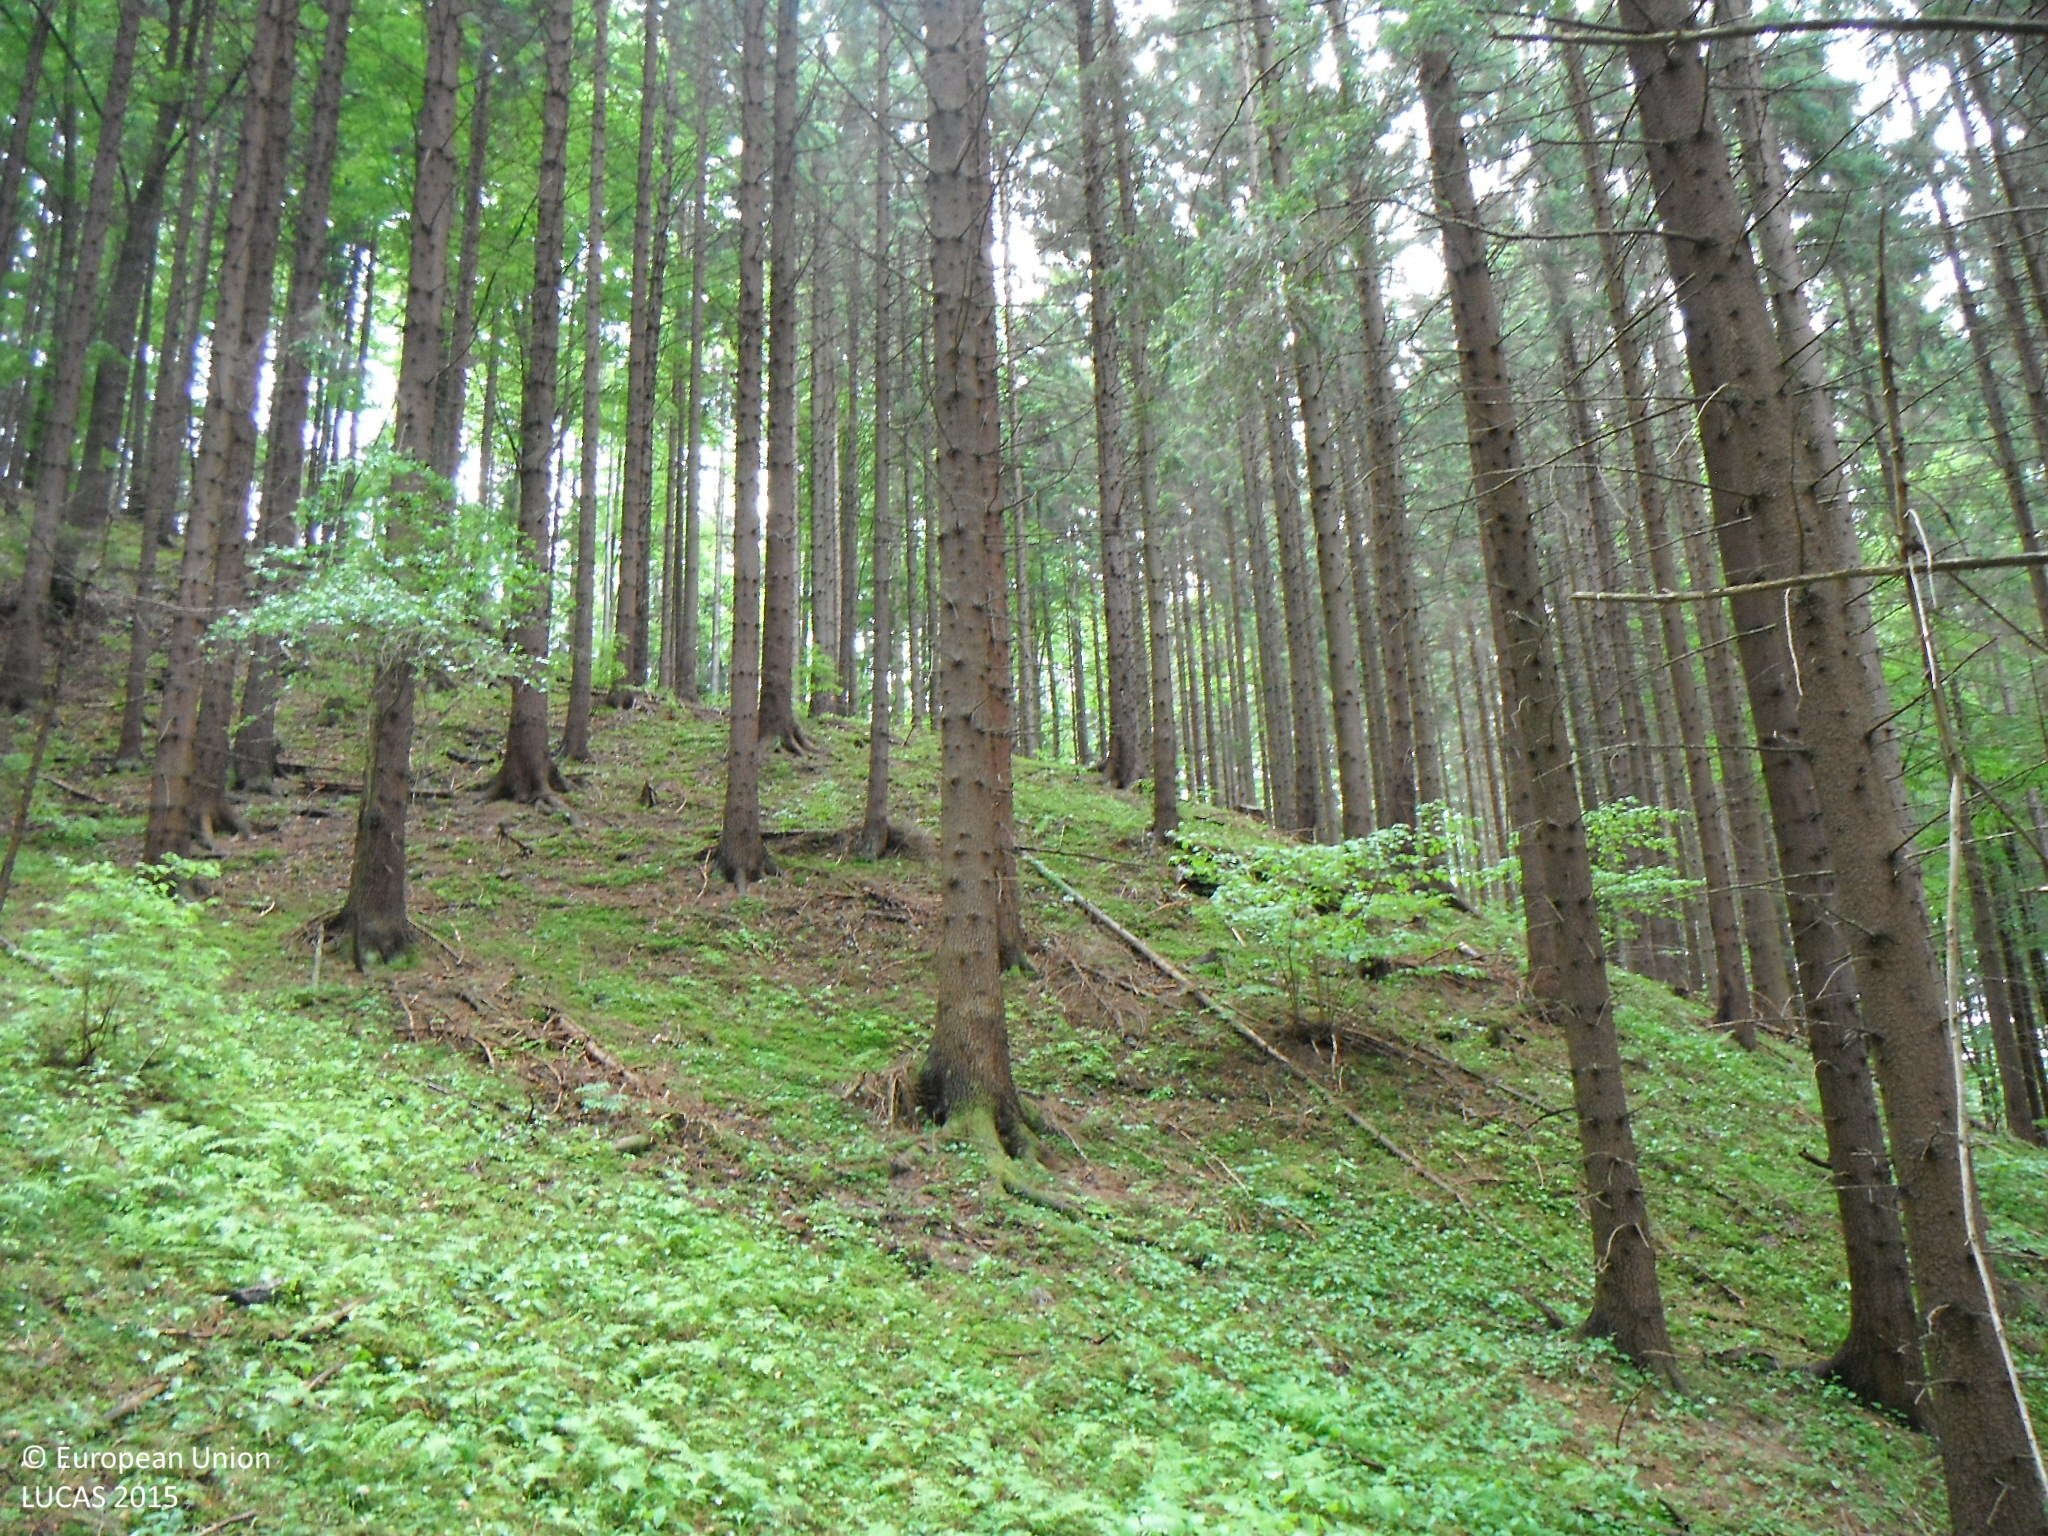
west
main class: Woodland
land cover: Spruce dominated coniferous woodland
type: alpine coniferous forest
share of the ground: > 75 %
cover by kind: coniferous forest trees 100 %
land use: Forestry
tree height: > 5 m
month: May
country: SK
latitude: 48.9929
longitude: 19.0283
